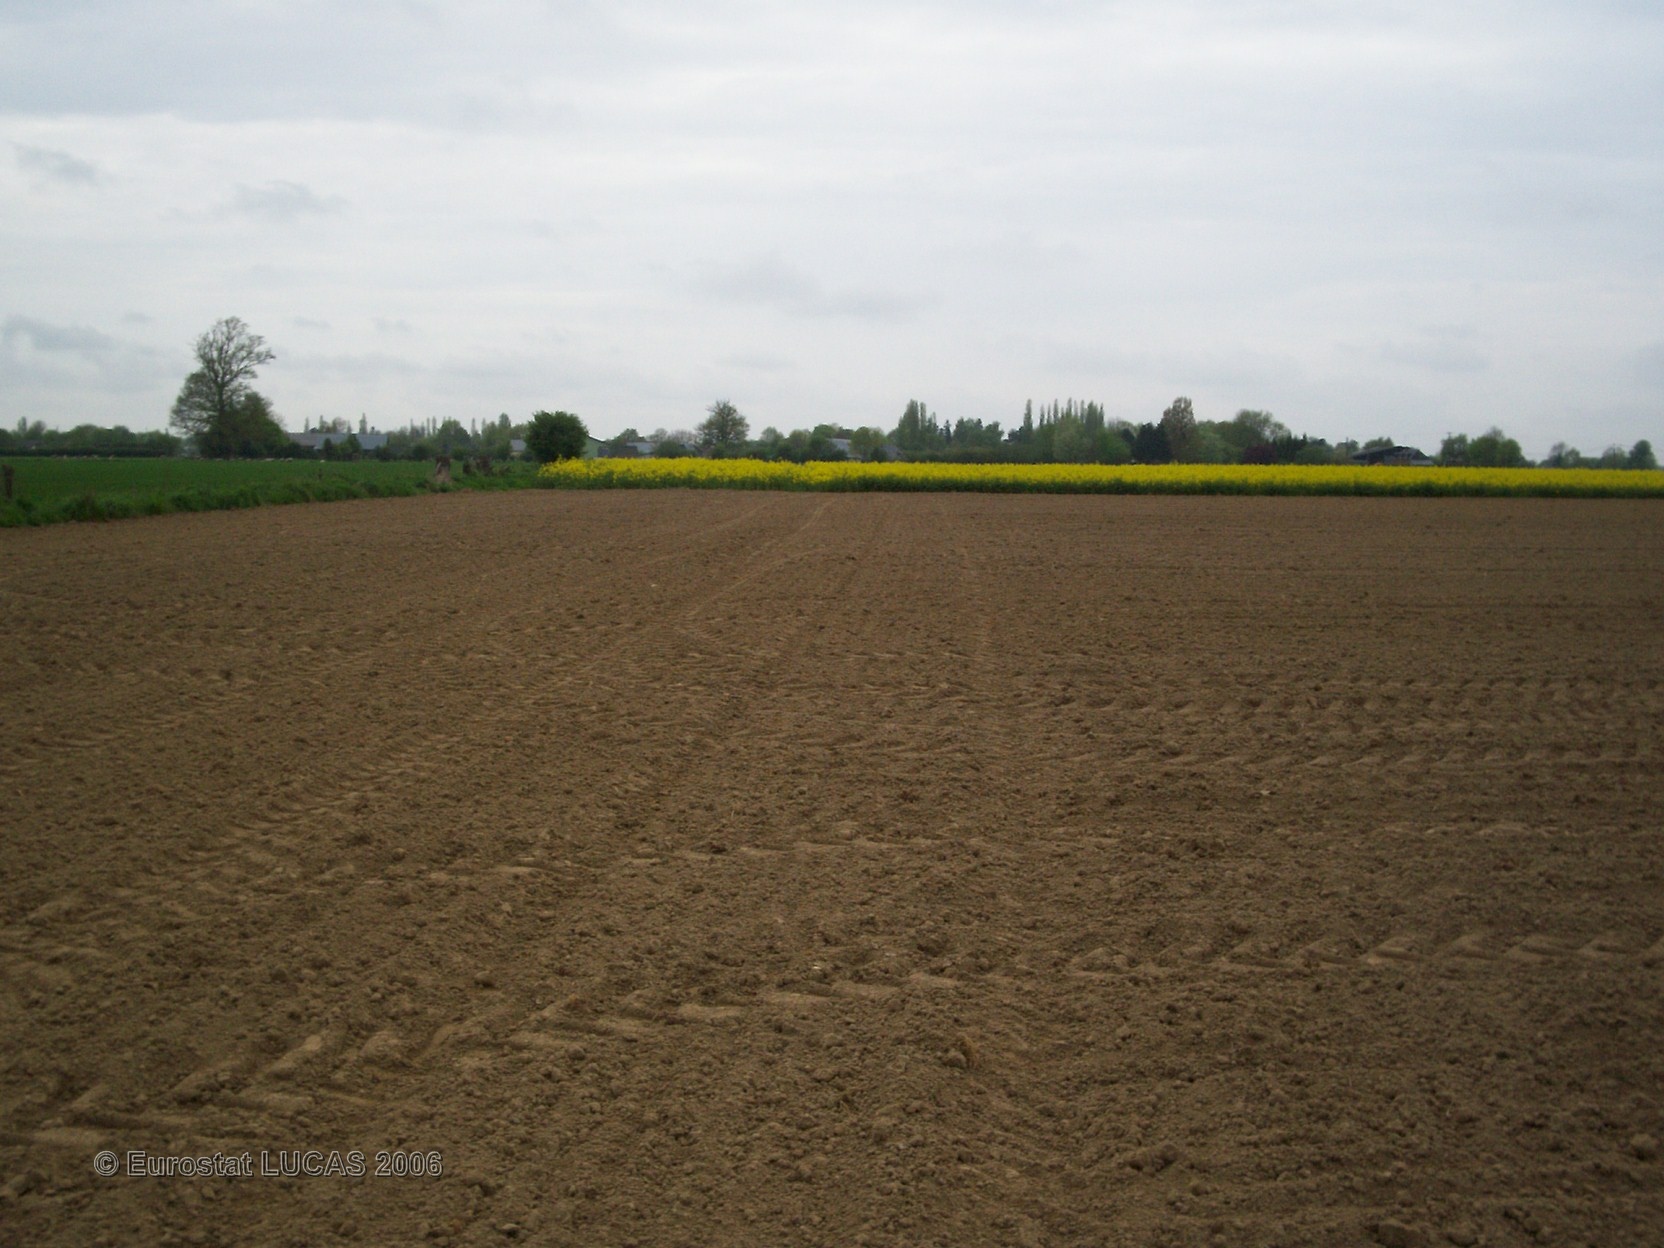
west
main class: Cropland
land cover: Maize
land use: Agriculture (excluding fallow land and kitchen gardens)
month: May
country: FR
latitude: 48.9615
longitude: 0.5917
